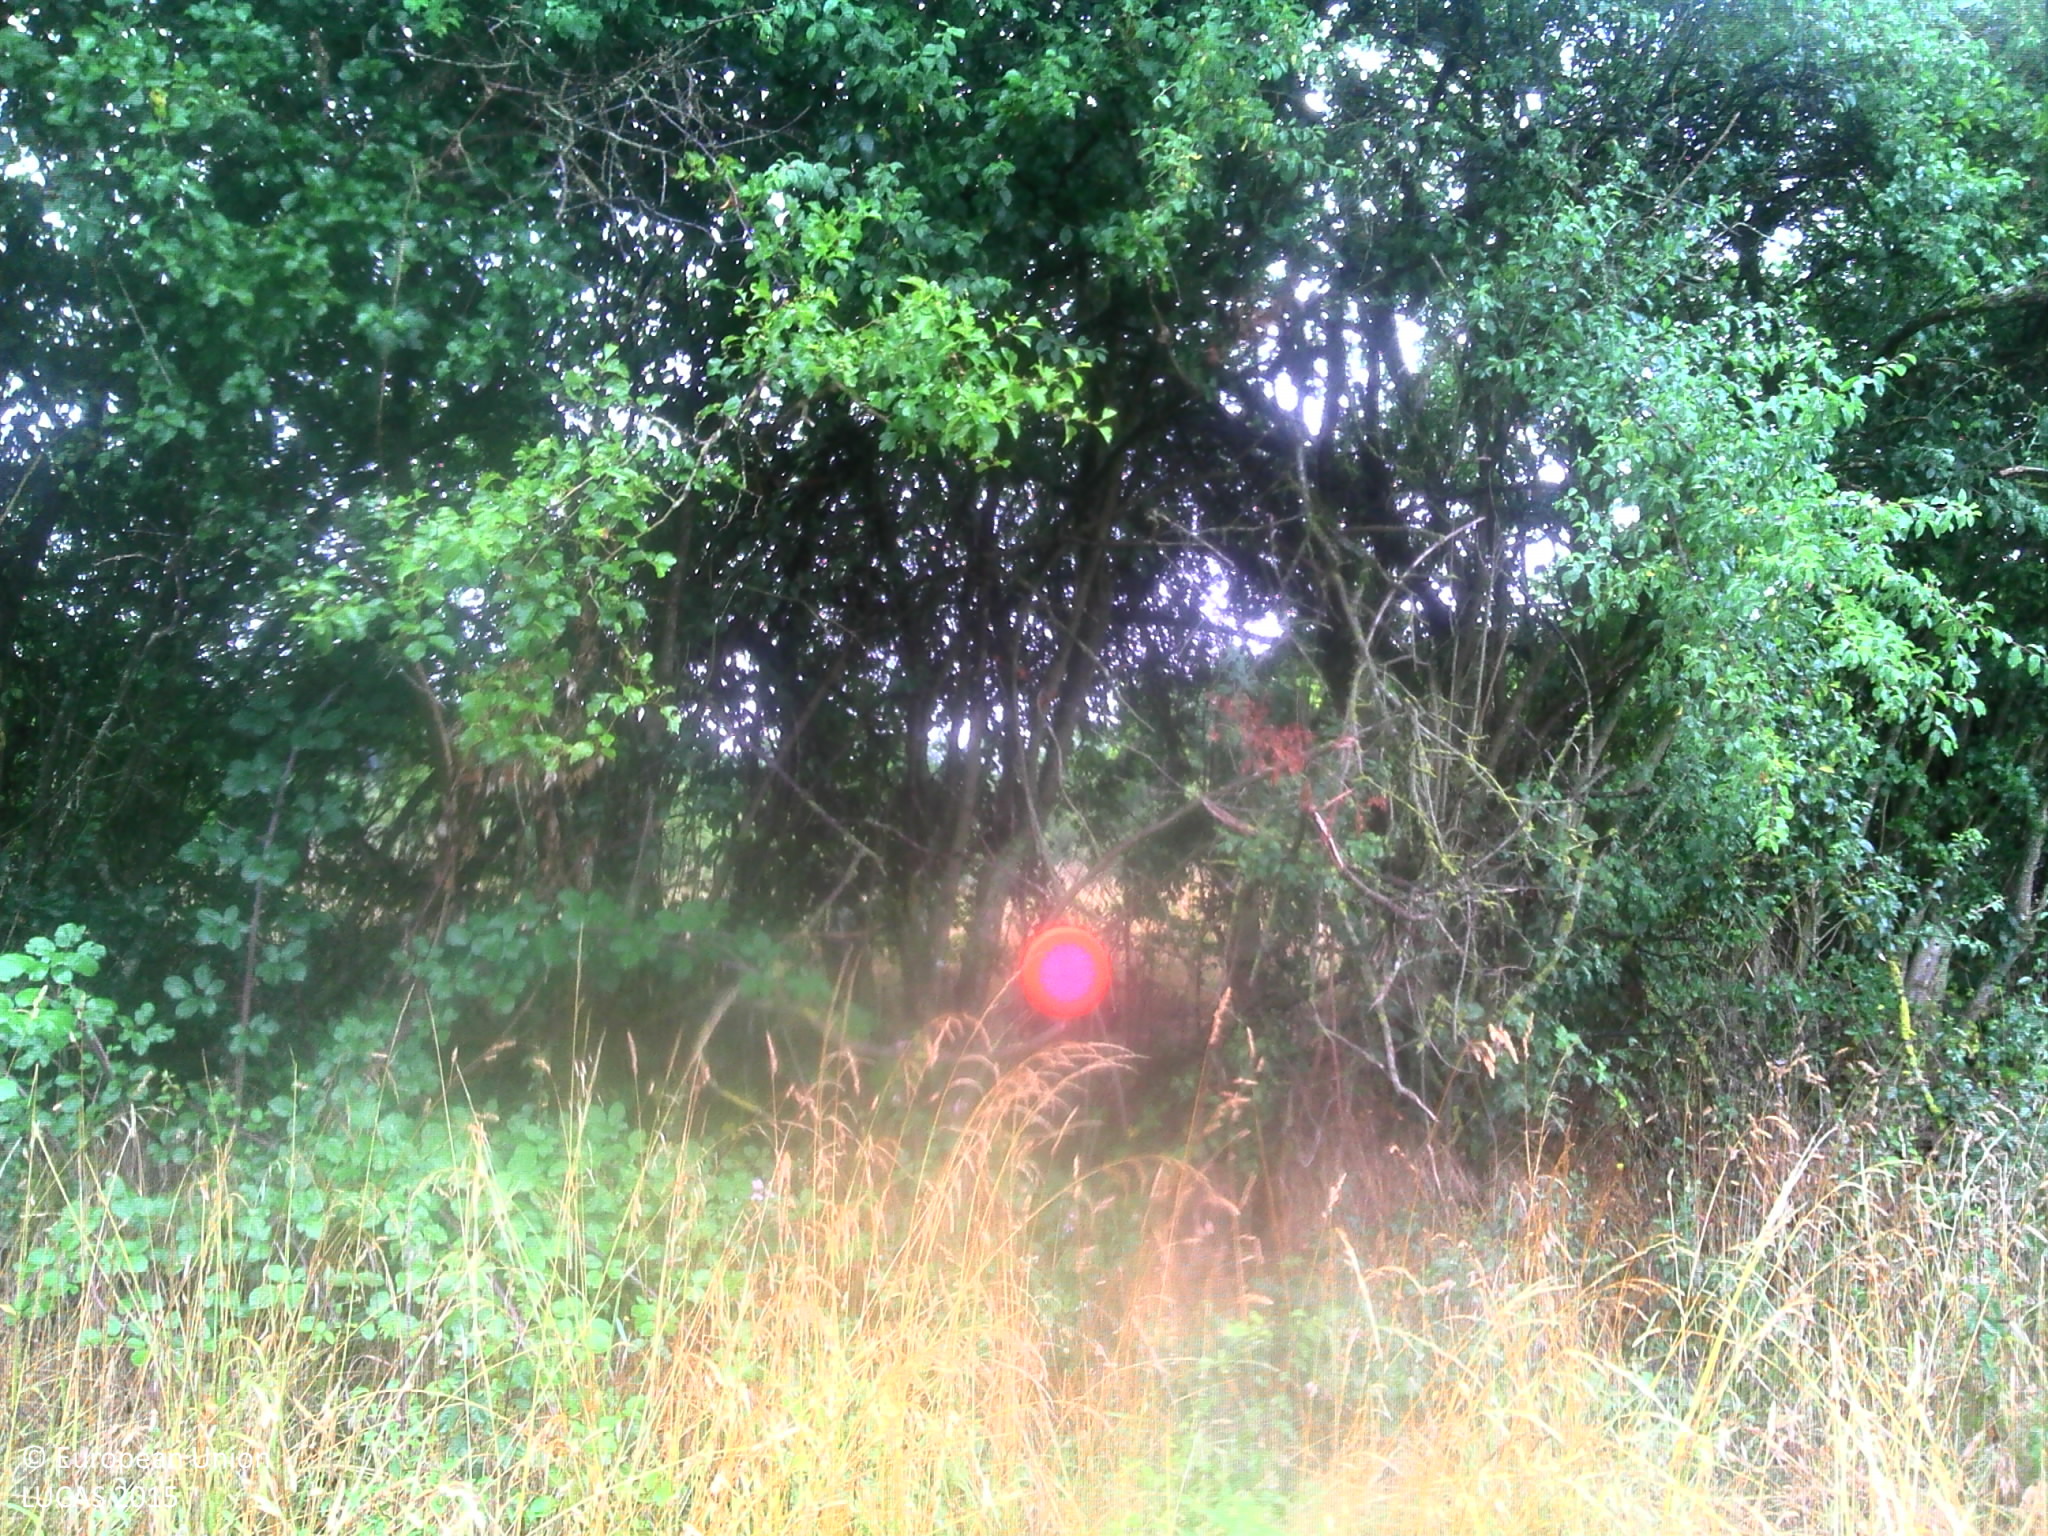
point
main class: Woodland
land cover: Broadleaved woodland
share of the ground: > 75 %
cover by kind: broadleaved forest trees 100 %
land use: Semi-natural and natural areas not in use
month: July
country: BE
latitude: 50.1687
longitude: 4.6903
